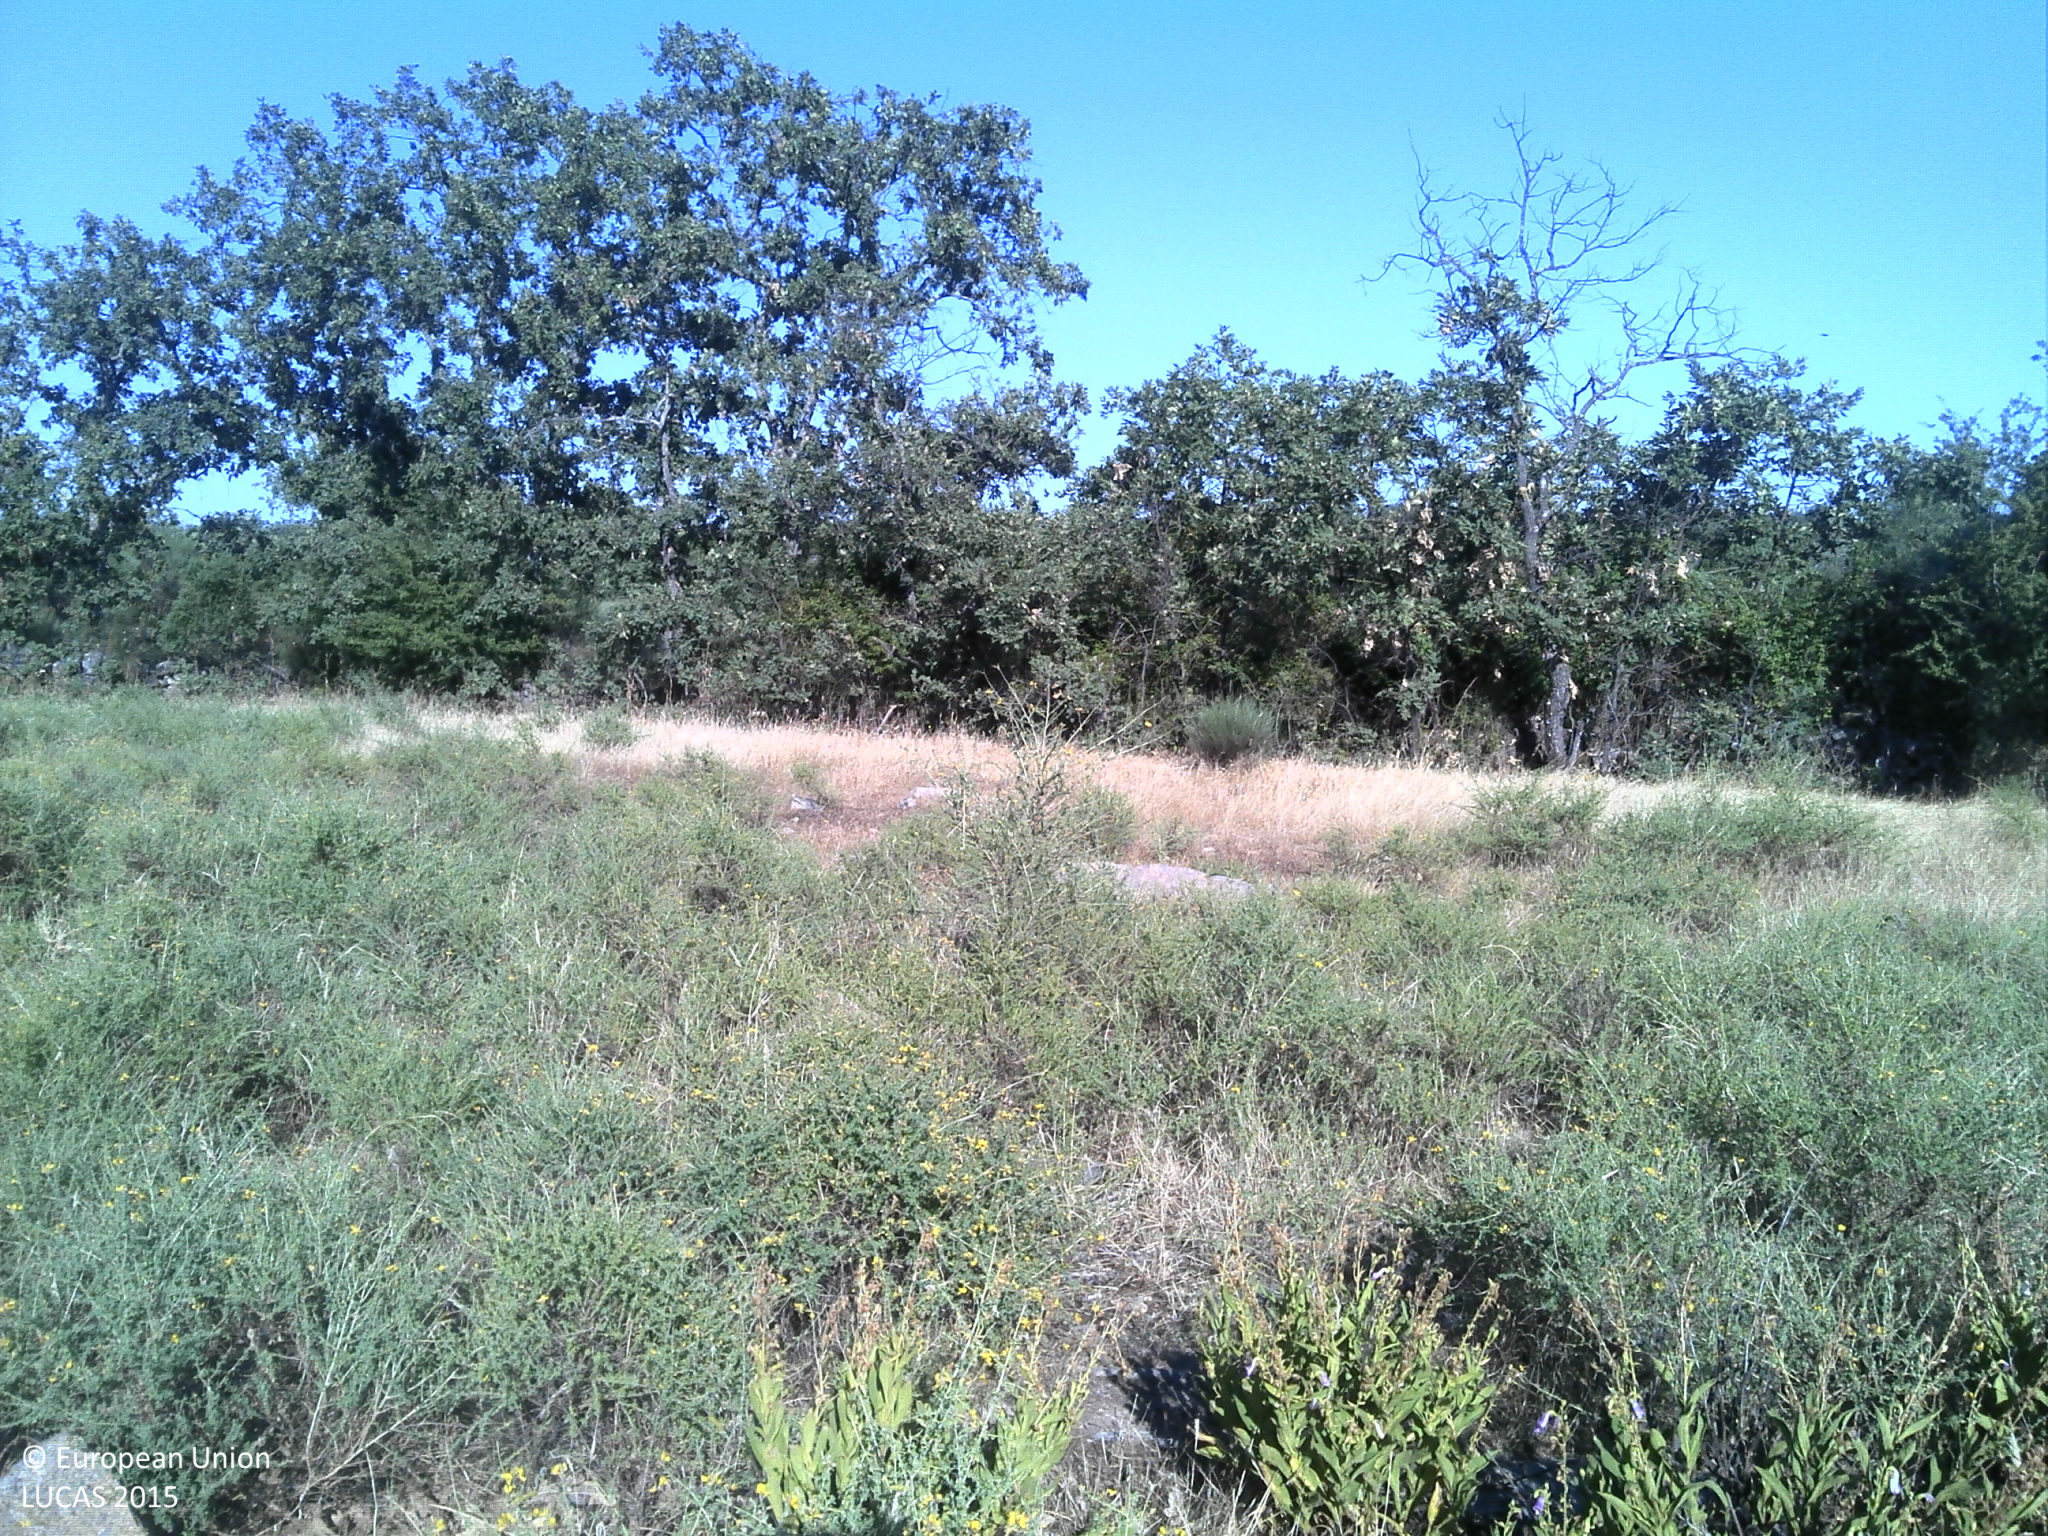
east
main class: Grassland
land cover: Grassland with sparse tree/shrub cover
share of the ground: 25 - 50 %
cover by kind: herbaceous plants 45 %, unconsolidated bare surface 40 %, broadleaved forest trees 5 %, shrubs 5 %
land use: Agriculture (excluding fallow land and kitchen gardens)
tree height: > 5 m
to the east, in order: Grassland with sparse tree/shrub cover; Fences; Dry stone walls; Fences; Abandoned hedges; Grassland with sparse tree/shrub cover; Abandoned hedges; Fences; Dry stone walls; Grassland with sparse tree/shrub cover; Grassland without tree/shrub cover; Dry stone walls; Abandoned hedges; Grassland without tree/shrub cover; Grassland with sparse tree/shrub cover
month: June
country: PT
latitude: 39.9766
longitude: -7.2740
